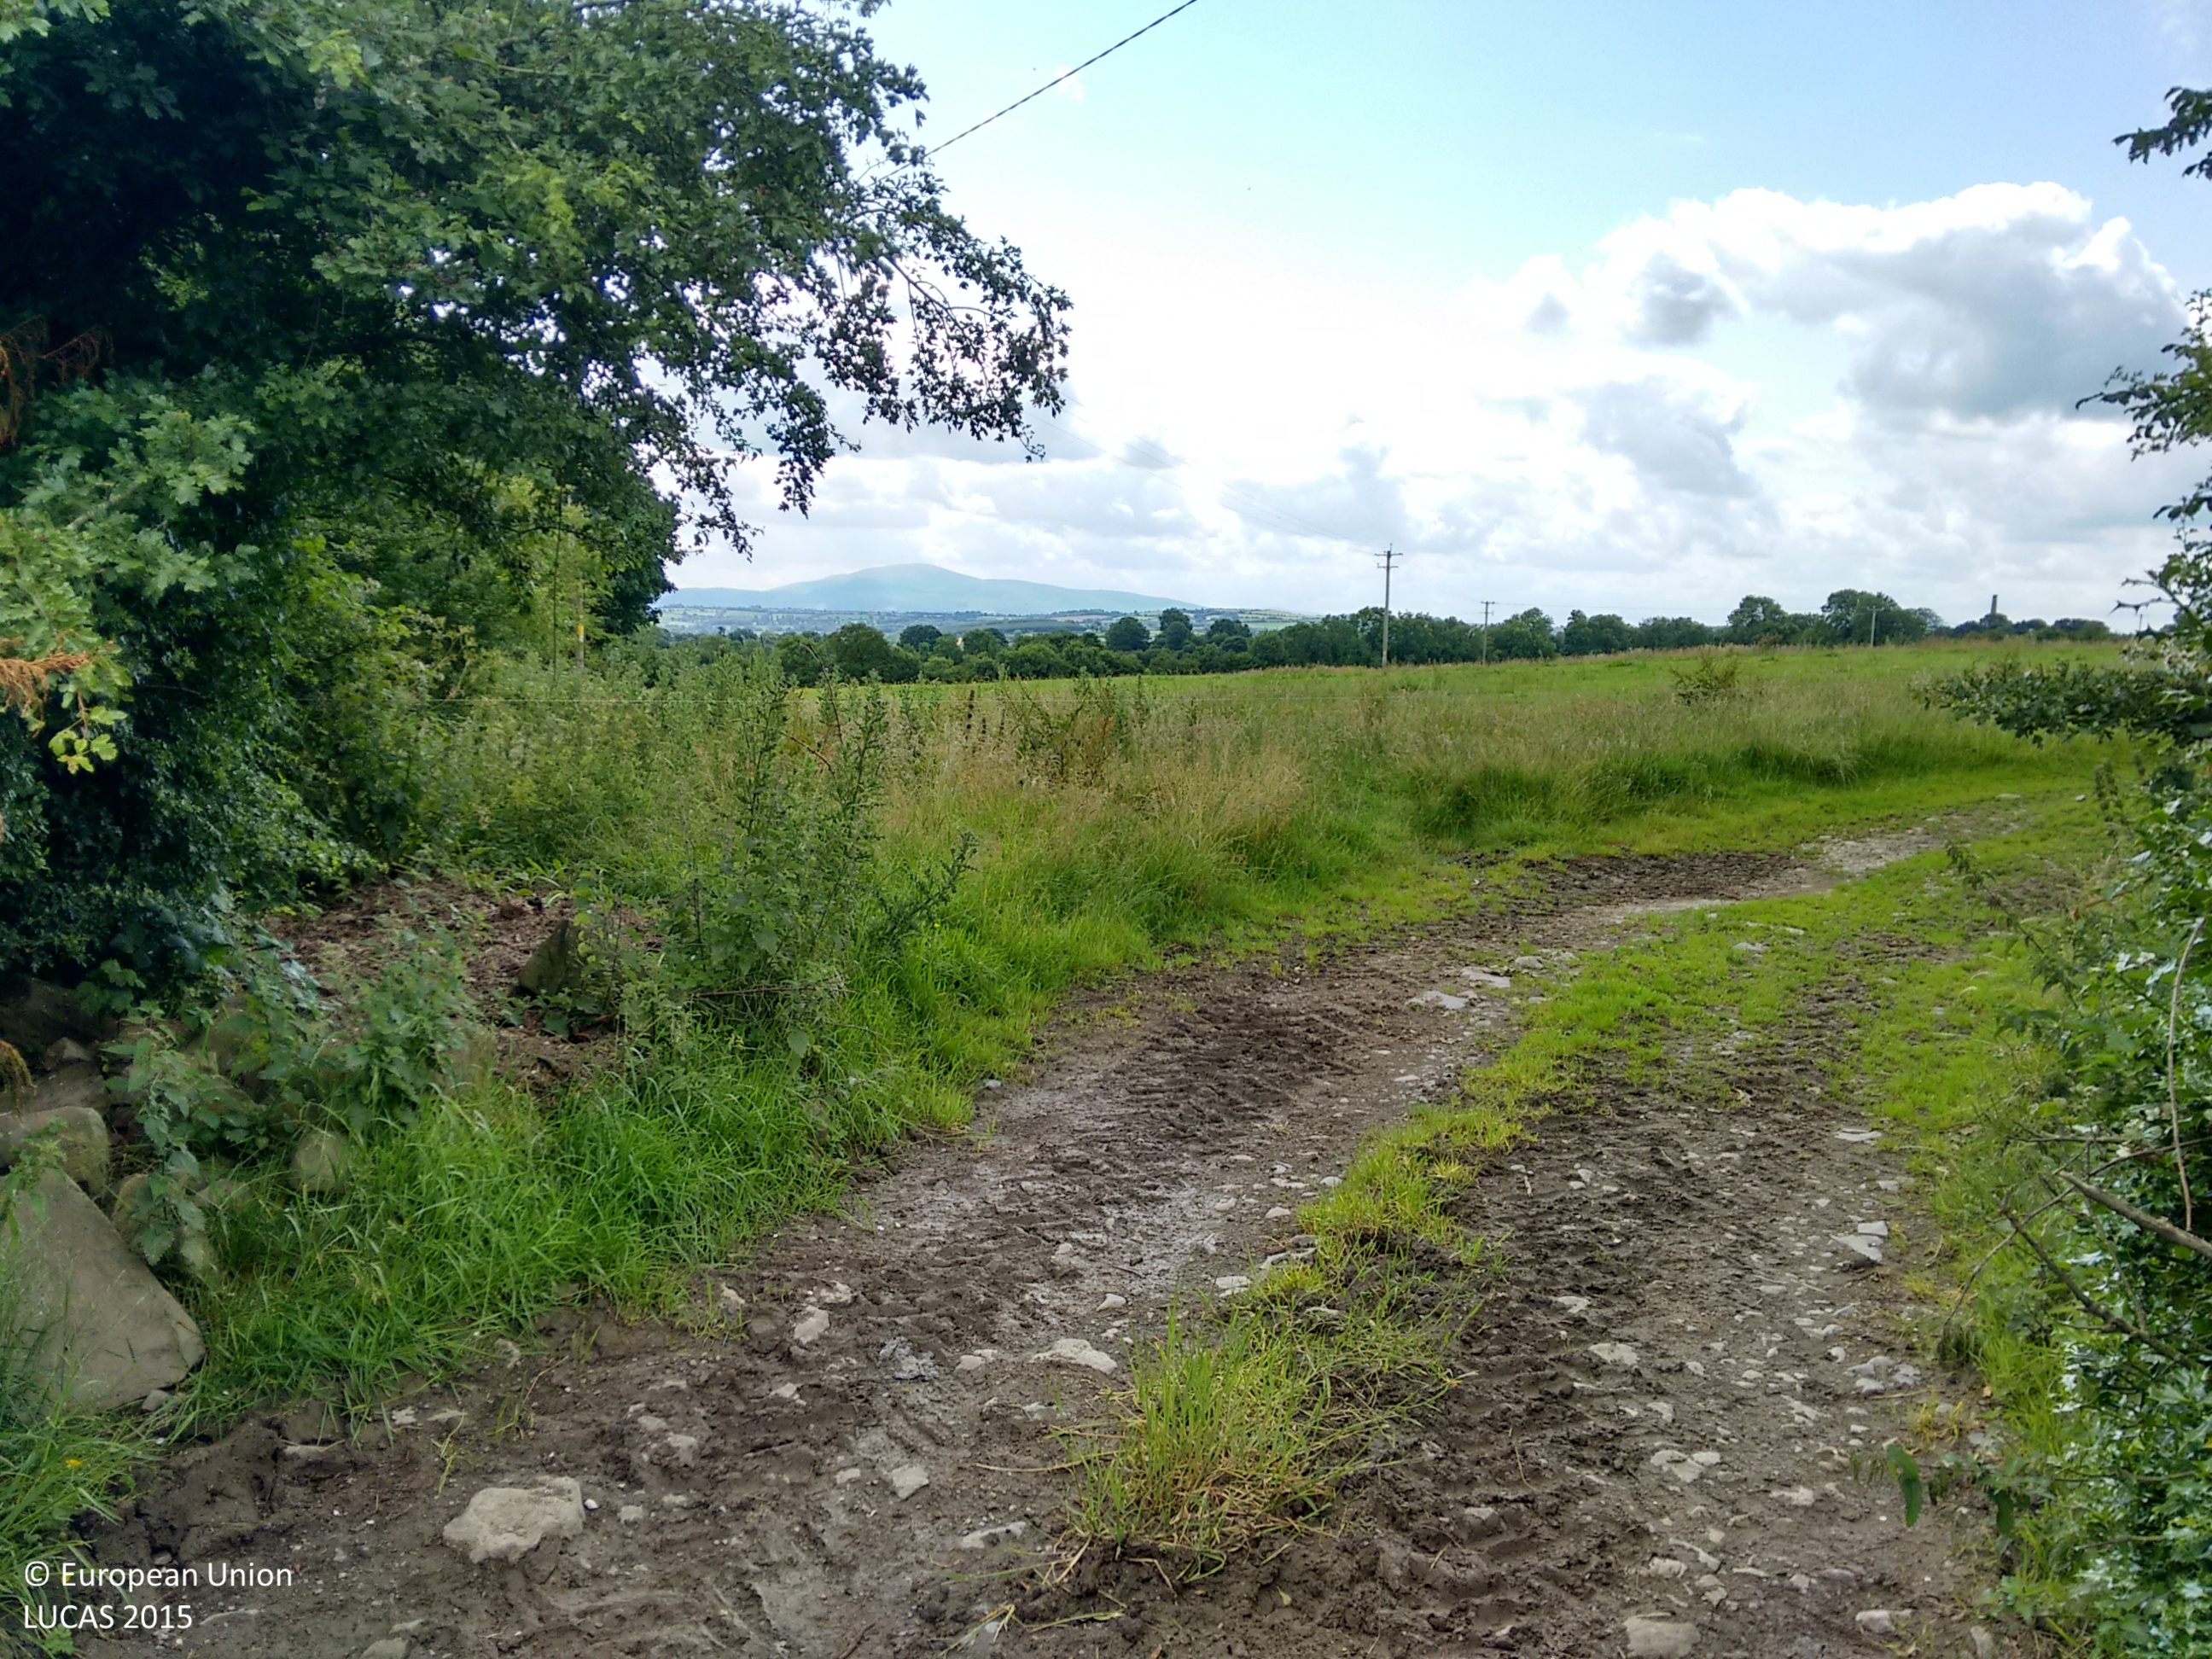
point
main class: Grassland
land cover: Grassland without tree/shrub cover
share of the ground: > 75 %
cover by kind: herbaceous plants 100 %
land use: Agriculture (excluding fallow land and kitchen gardens)
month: July
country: IE
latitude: 52.5999
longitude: -7.5683
